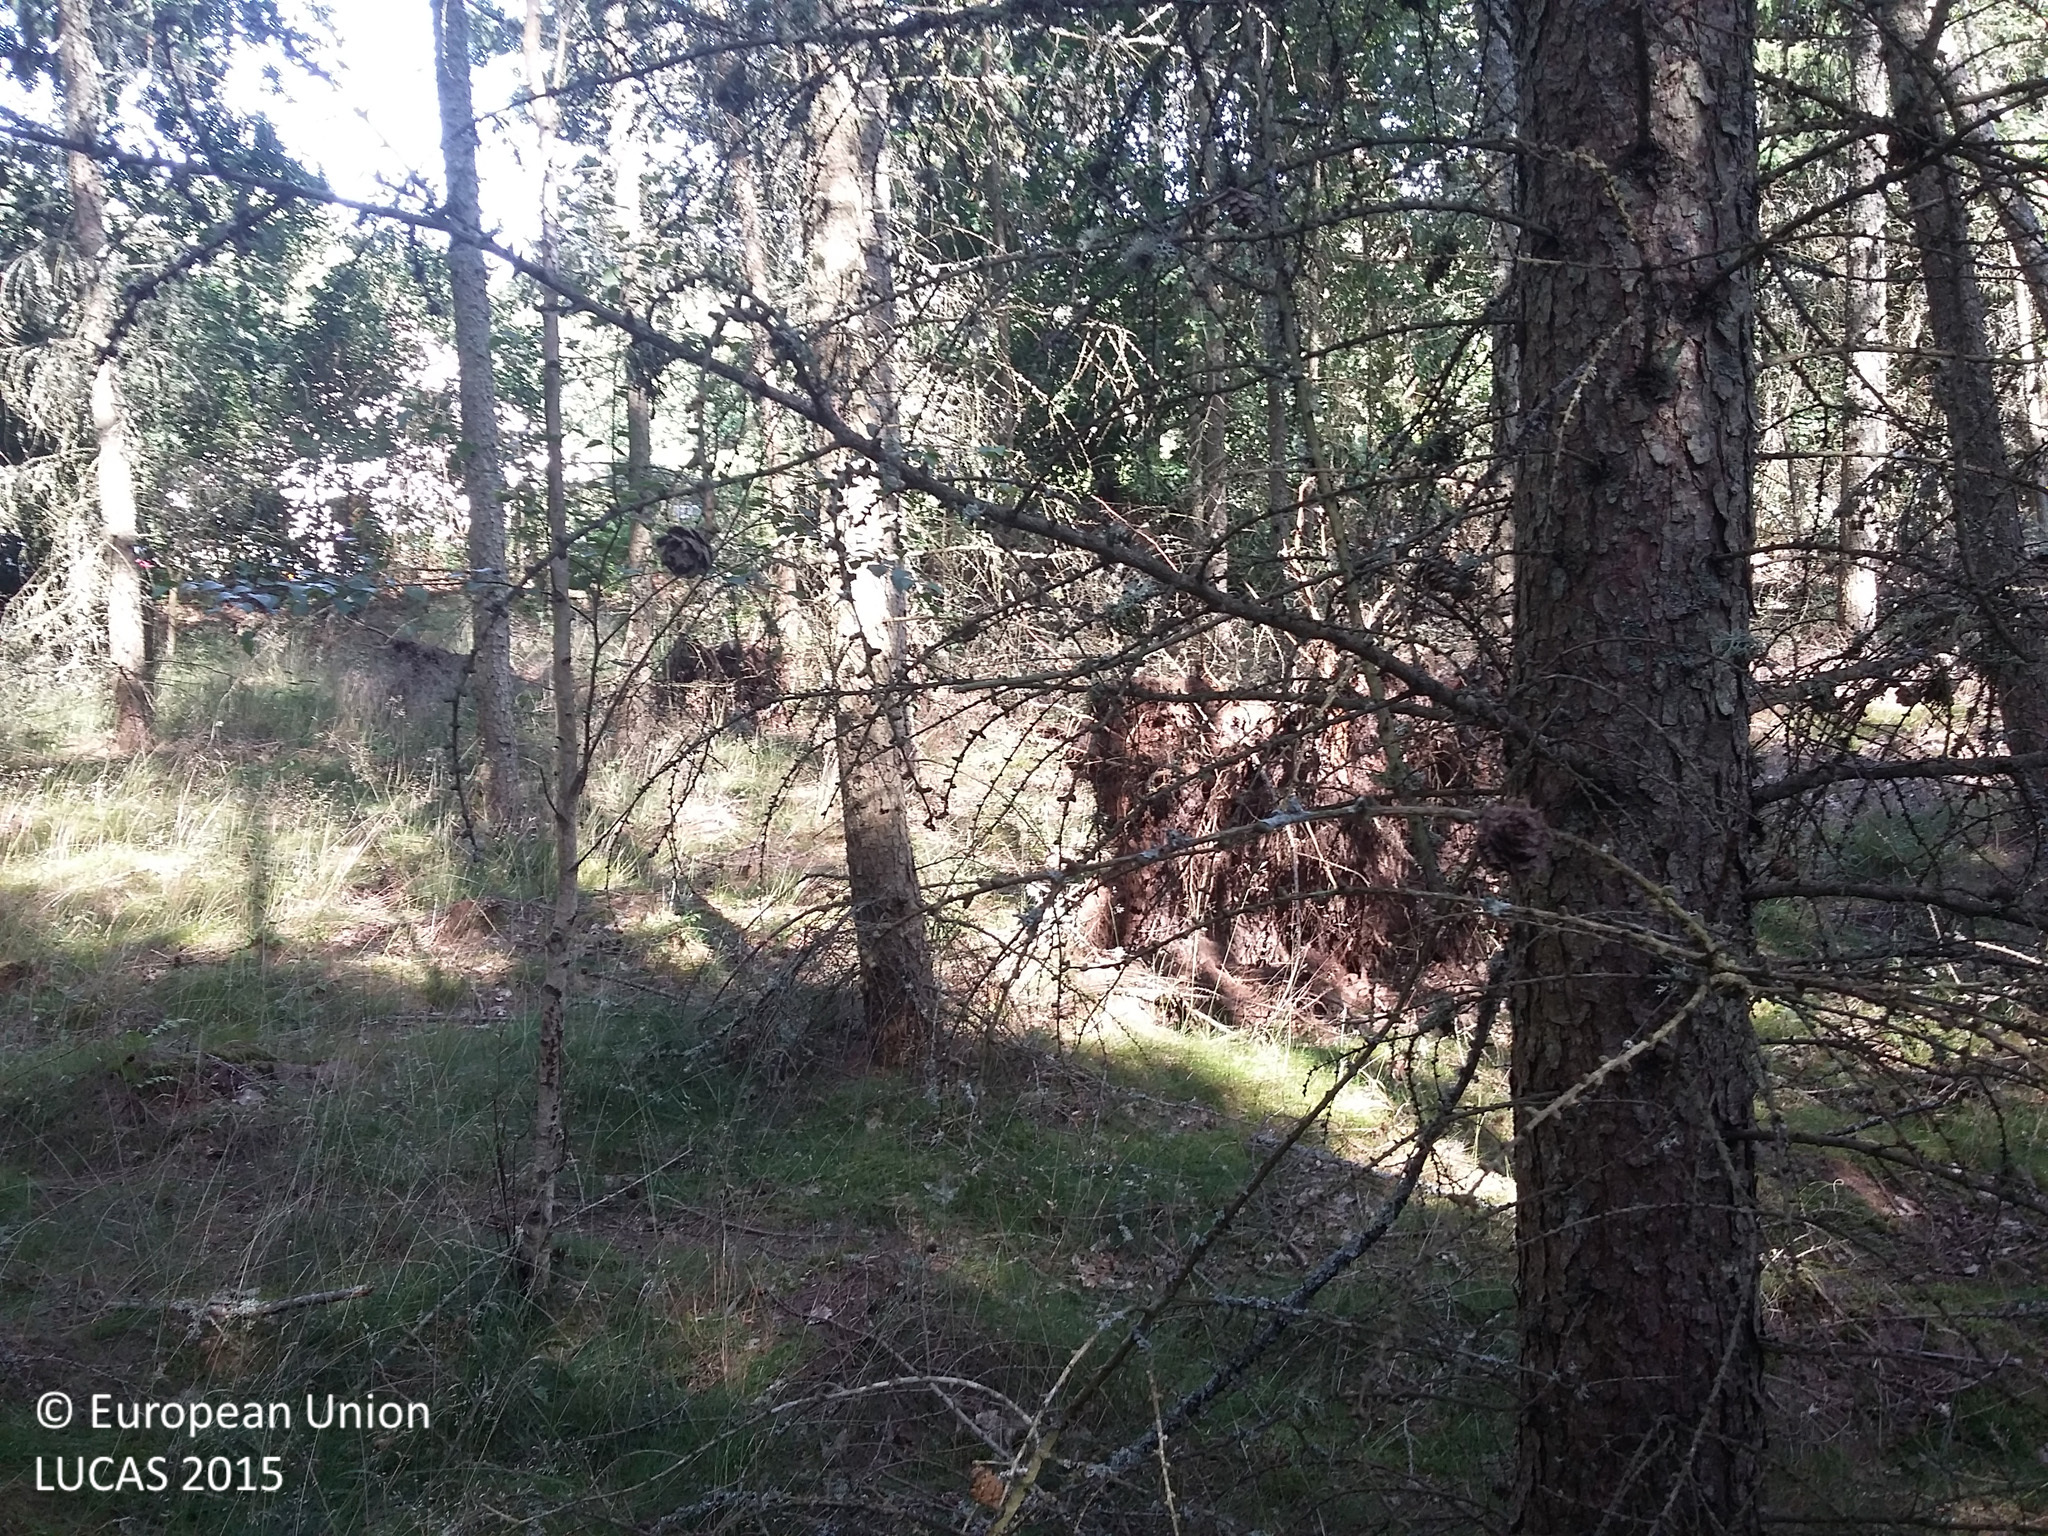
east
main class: Woodland
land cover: Pine dominated coniferous woodland
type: alpine coniferous forest
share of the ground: > 75 %
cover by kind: coniferous forest trees 80 %, herbaceous plants 10 %, lichens and mosses 10 %
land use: Forestry
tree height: > 5 m
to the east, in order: Pine dominated coniferous woodland; Dry stone walls; Artificial constructions in urban areas; Broadleaved woodland; Tracks; Broadleaved woodland; Tracks; Broadleaved woodland; Inland marshes; Ditches and canals; Broadleaved woodland
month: July
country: DK
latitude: 56.0447
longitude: 12.1009
